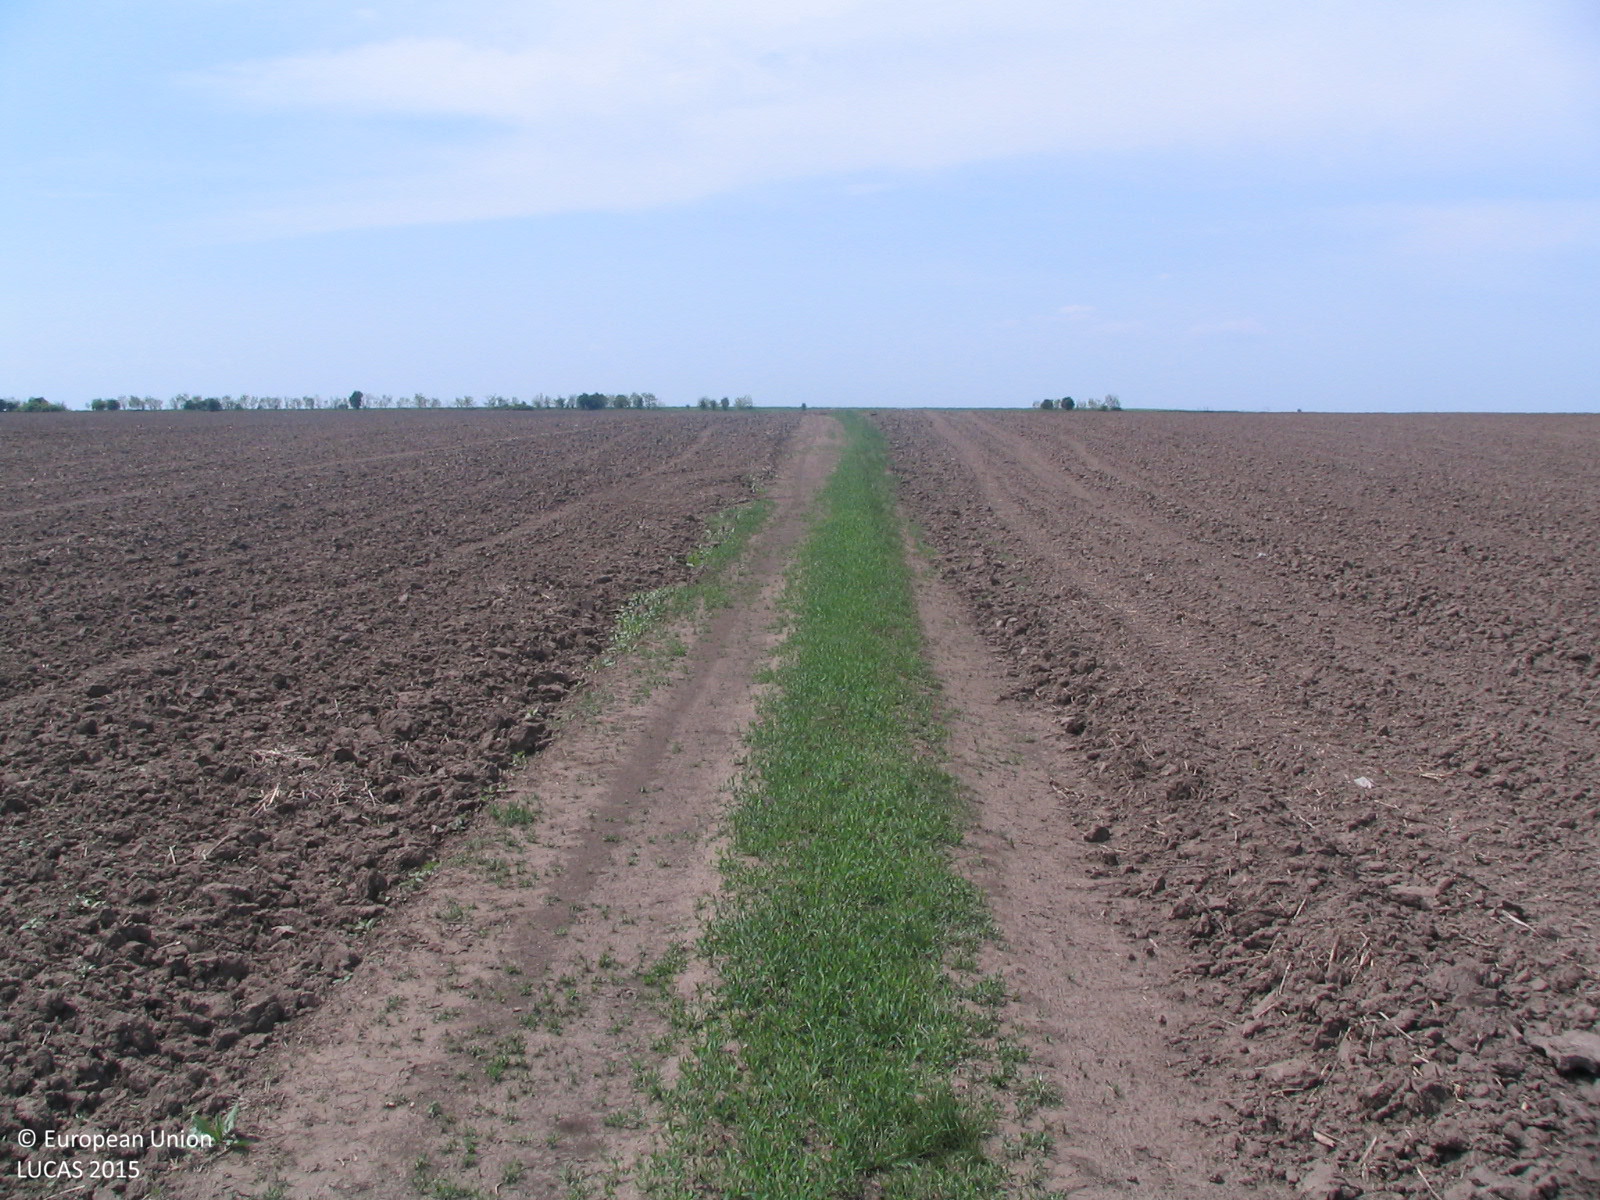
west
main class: Cropland
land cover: Sunflower
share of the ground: < 10 %
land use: Agriculture (excluding fallow land and kitchen gardens)
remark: Harvested field
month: May
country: BG
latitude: 43.6373
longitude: 23.9739
